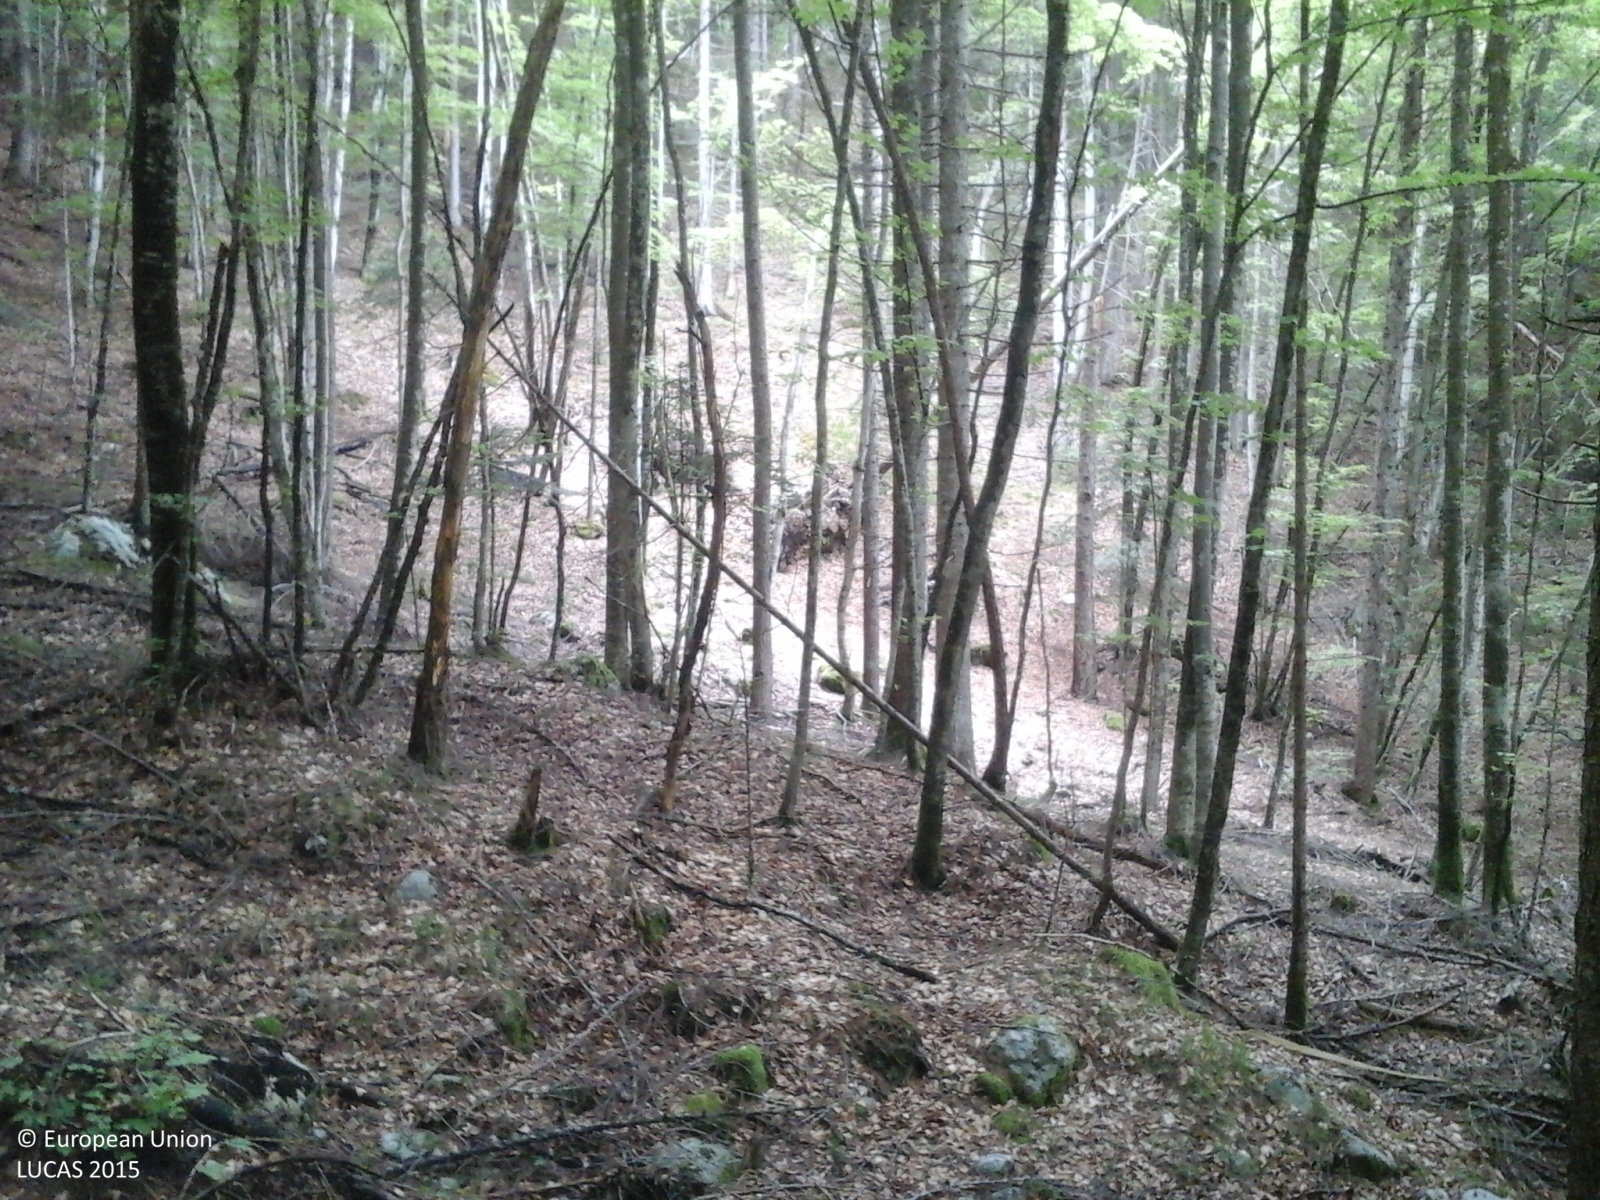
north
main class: Woodland
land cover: Other mixed woodland
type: alpine coniferous forest
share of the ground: > 75 %
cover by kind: coniferous forest trees 60 %, broadleaved forest trees 40 %
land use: Forestry
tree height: > 5 m
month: May
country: IT
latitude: 45.8584
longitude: 11.1703
